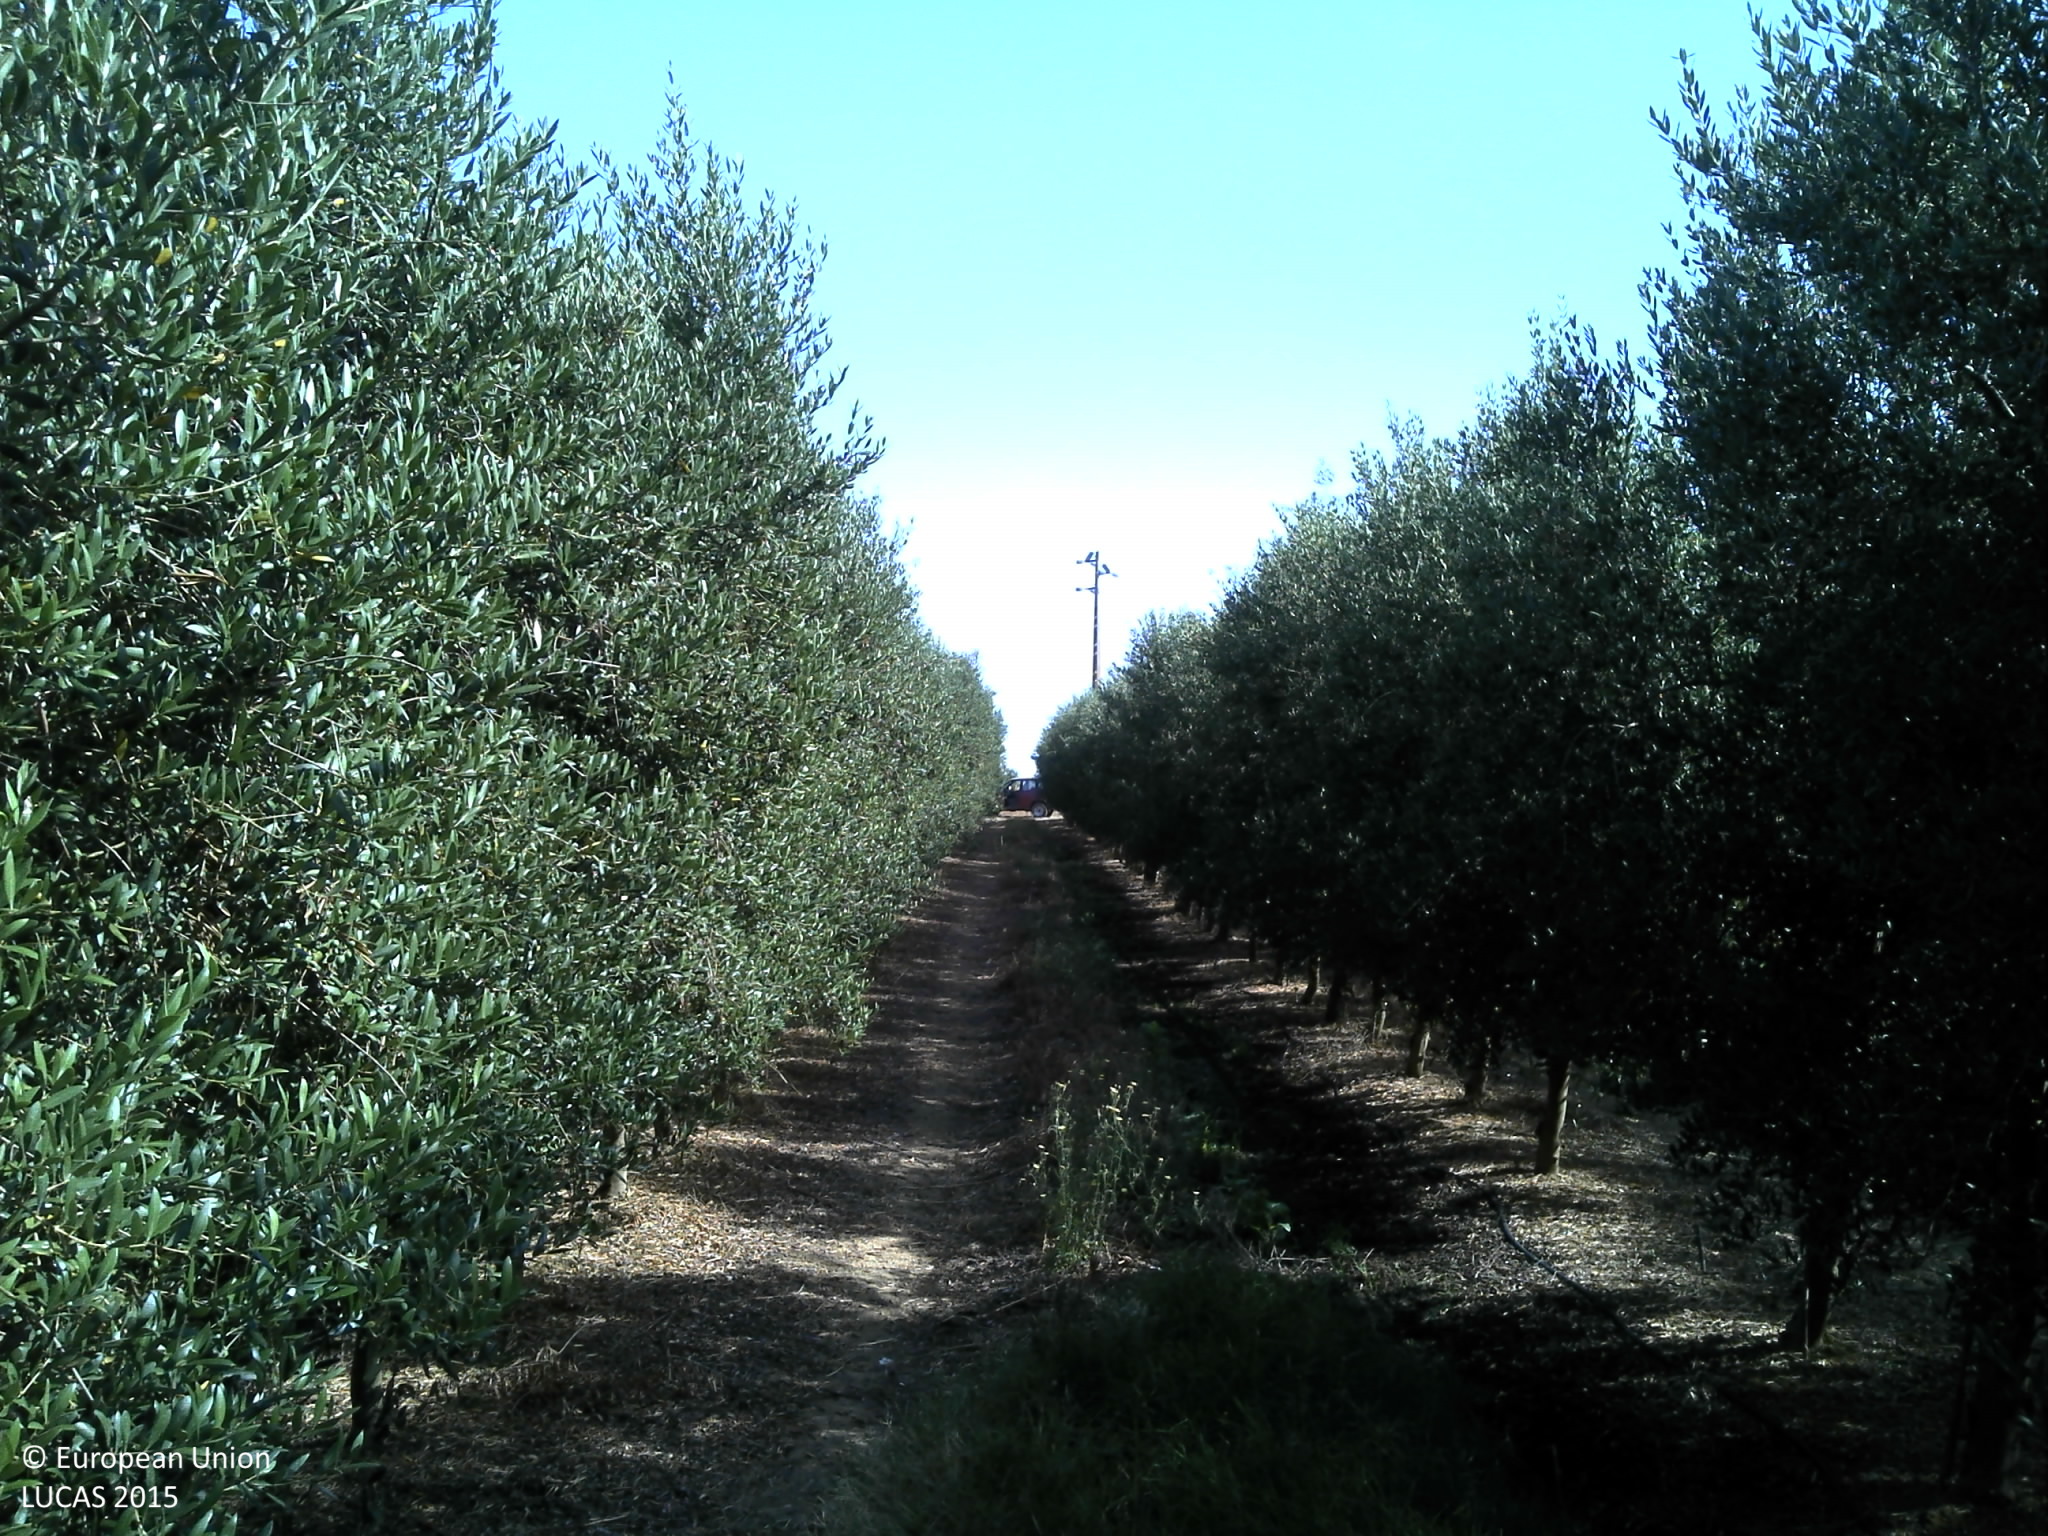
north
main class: Cropland
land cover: Olive groves
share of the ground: 50 - 75 %
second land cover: Grassland without tree/shrub cover
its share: 25 - 50 %
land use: Agriculture (excluding fallow land and kitchen gardens)
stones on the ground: < 10 %
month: July
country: PT
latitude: 38.4166
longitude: -7.7274
